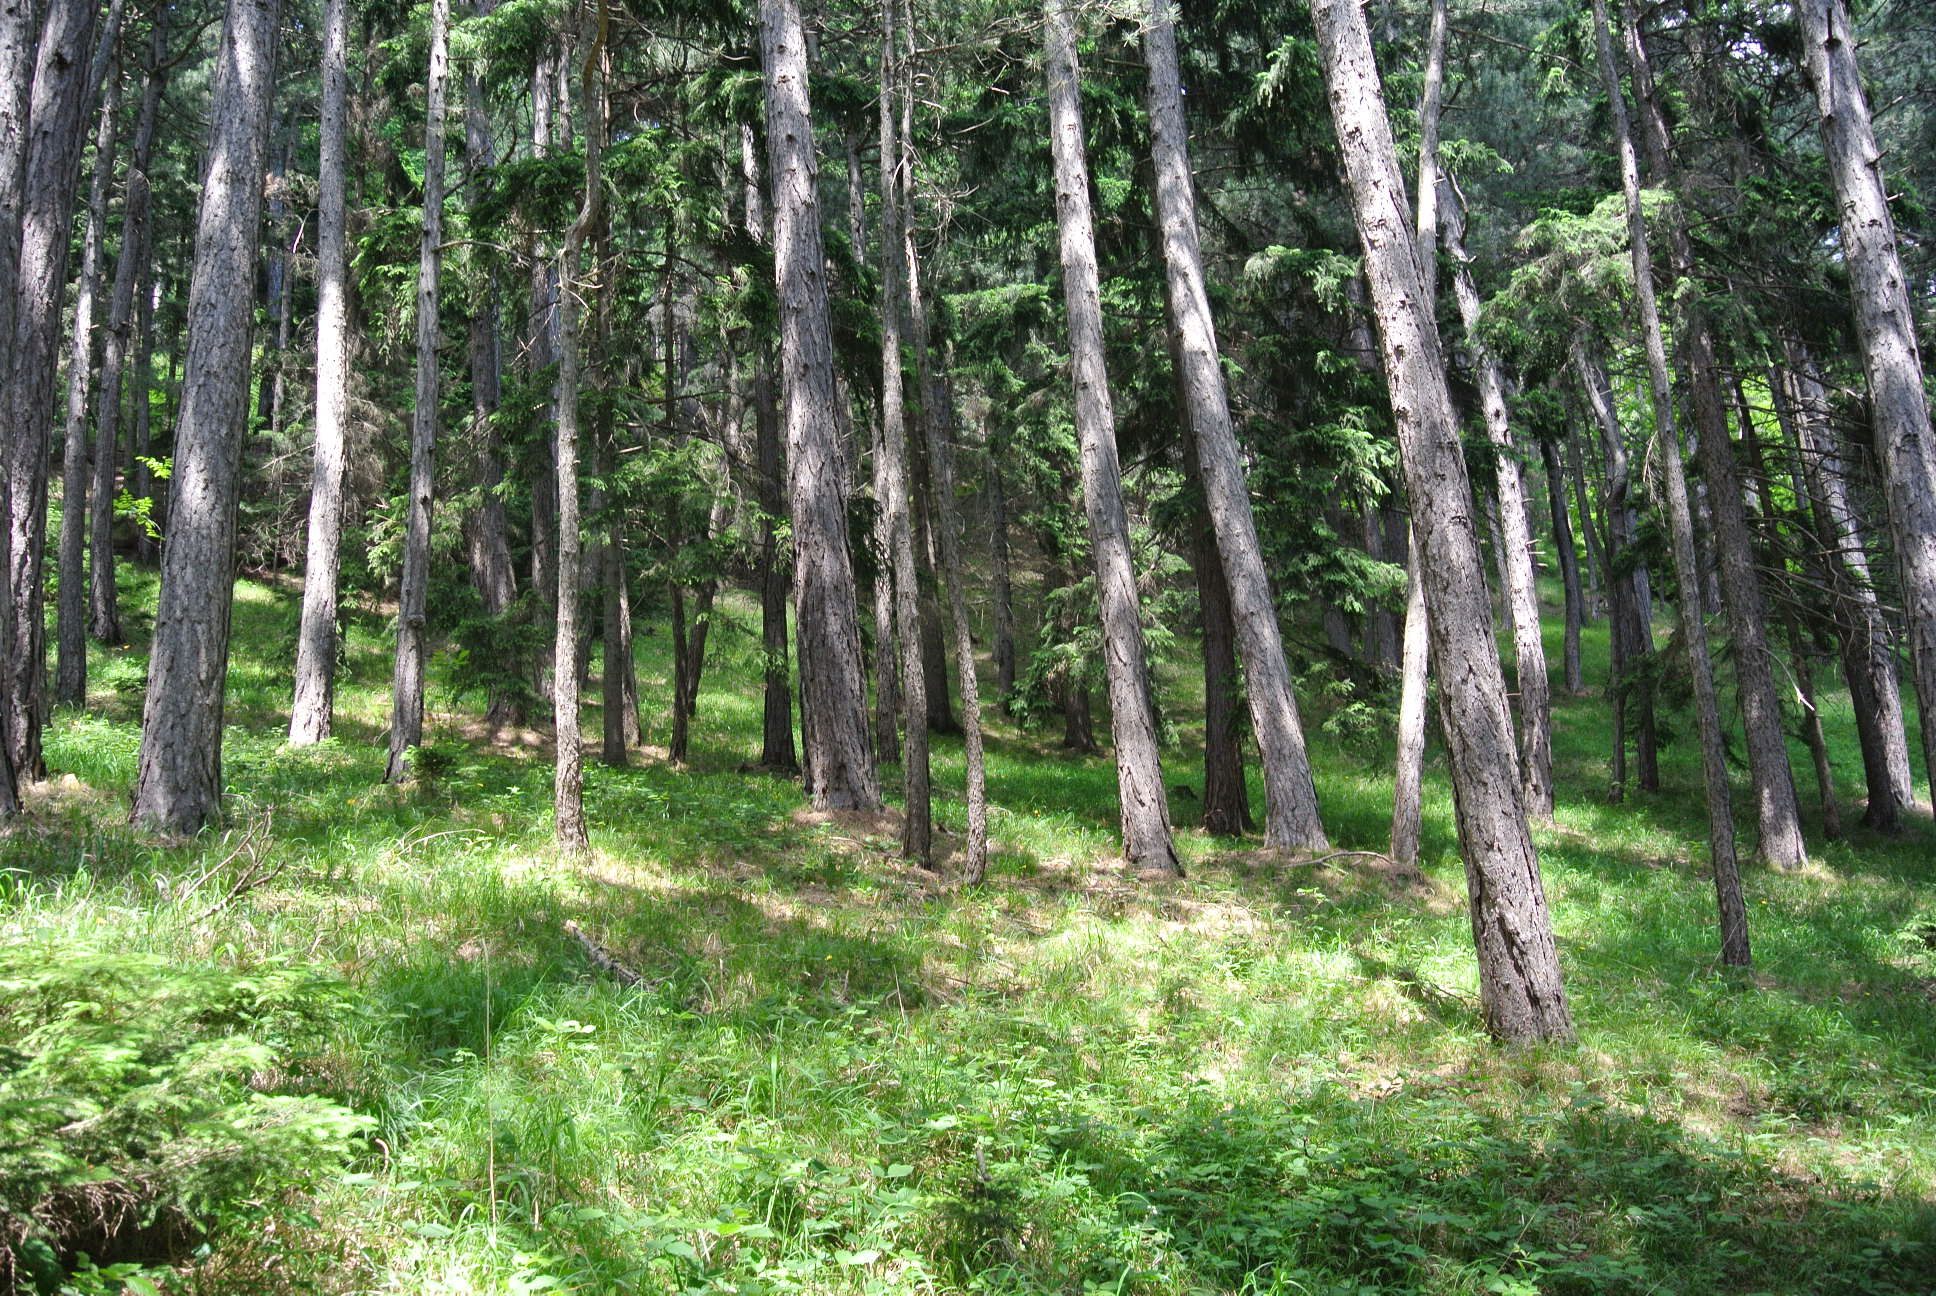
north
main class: Woodland
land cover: Pine dominated coniferous woodland
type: alpine coniferous forest
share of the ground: > 75 %
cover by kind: coniferous forest trees 85 %, herbaceous plants 15 %
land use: Forestry
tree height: > 5 m
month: May
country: AT
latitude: 47.8061
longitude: 16.0251
